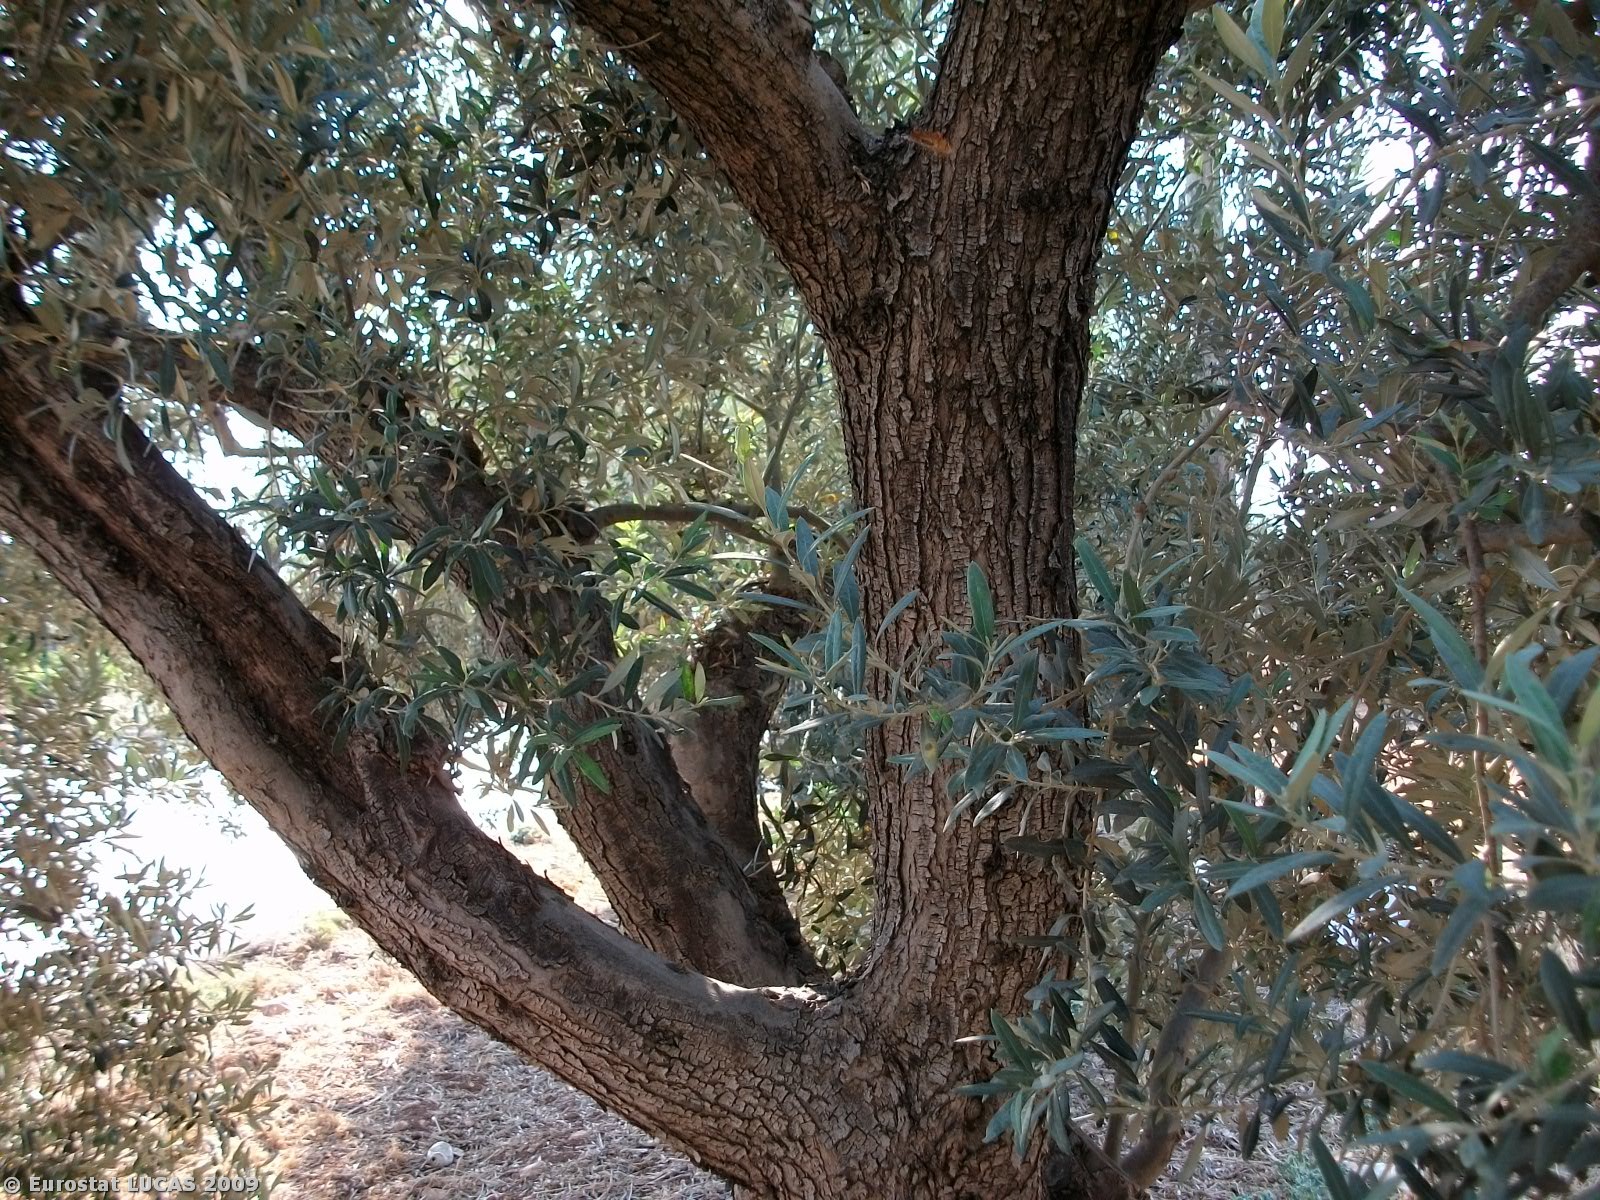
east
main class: Cropland
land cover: Olive groves
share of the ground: 50 - 75 %
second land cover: Grassland with sparse tree/shrub cover
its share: > 75 %
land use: Agriculture (excluding fallow land and kitchen gardens)
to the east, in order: Olive groves; Grassland with sparse tree/shrub cover; Grass margins; Paved roads, cycling and walking lanes; Electric lines; Grass margins; Olive groves; Grassland with sparse tree/shrub cover; Grass margins; Oranges; Grass margins; Olive groves; Grassland with sparse tree/shrub cover
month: August
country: GR
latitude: 37.8825
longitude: 22.9674
